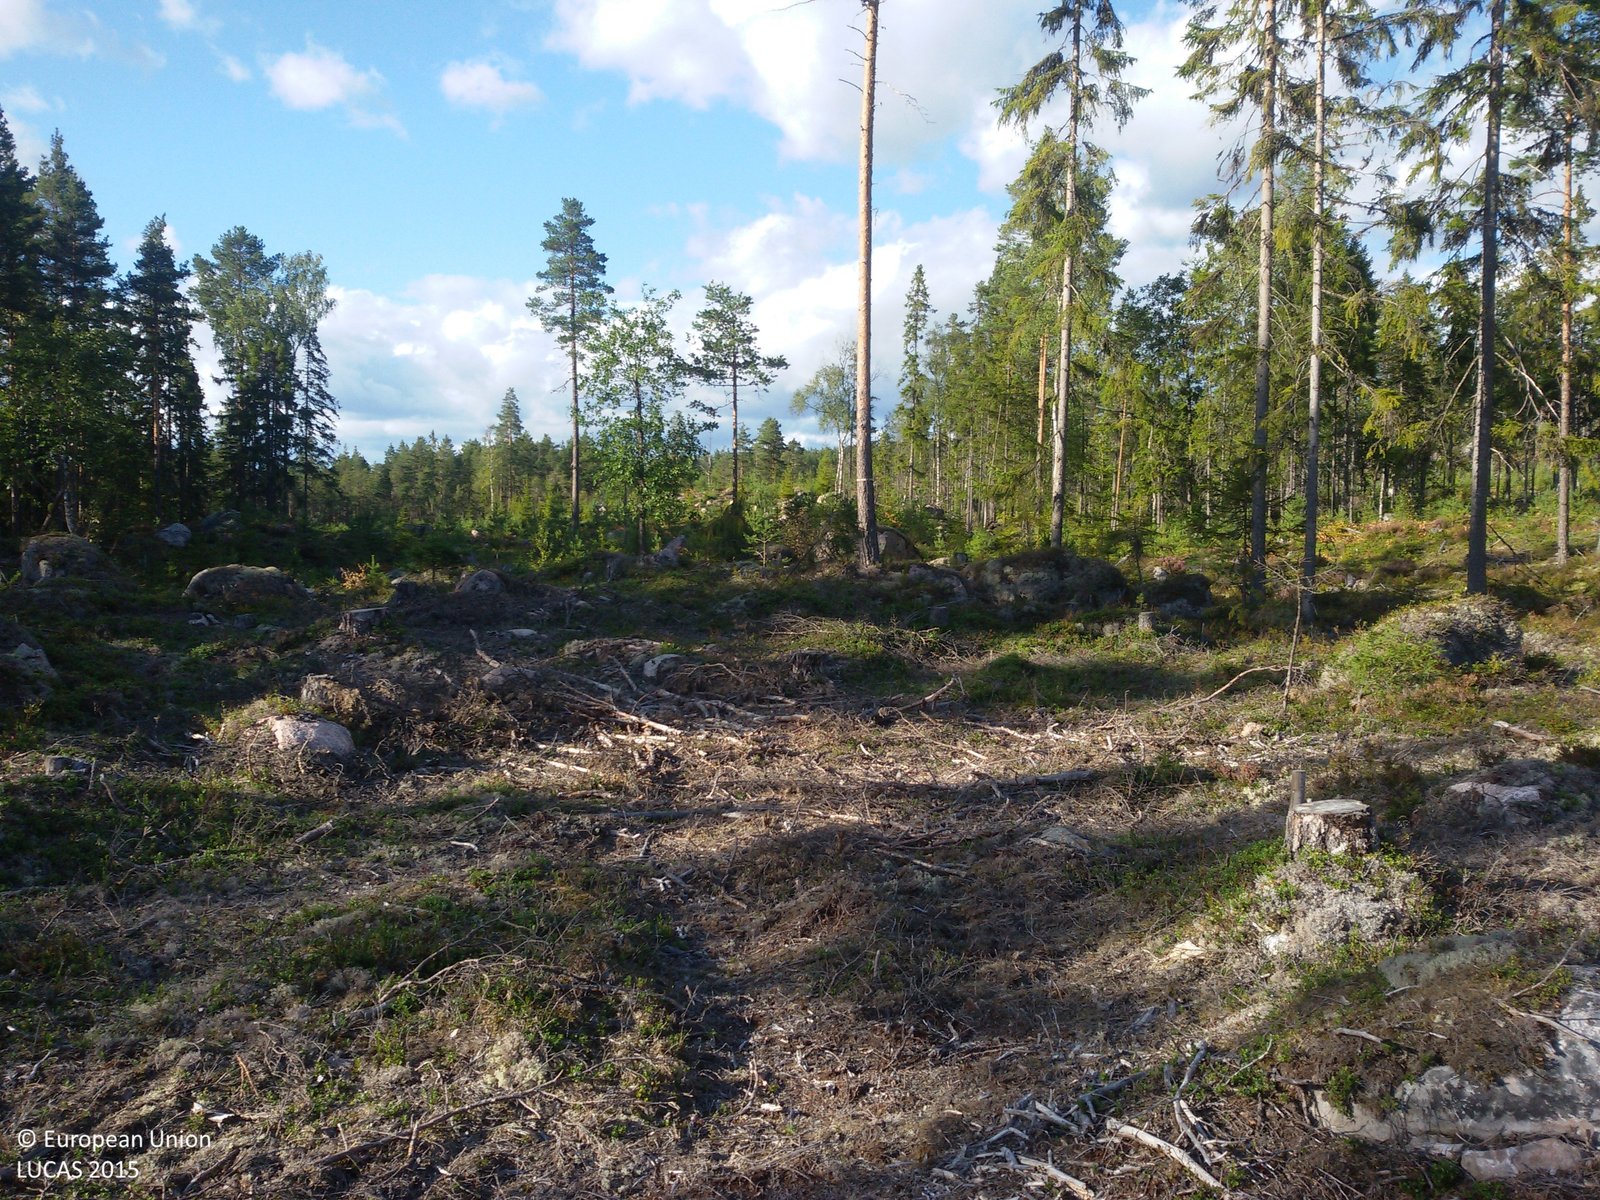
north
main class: Shrubland
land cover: Shrubland with sparse tree cover
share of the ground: 50 - 75 %
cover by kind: shrubs 70 %, lichens and mosses 10 %, coniferous forest trees 5 %
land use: Forestry
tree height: < 5 m
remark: Clear cut
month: August
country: SE
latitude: 60.9104
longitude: 15.7945
